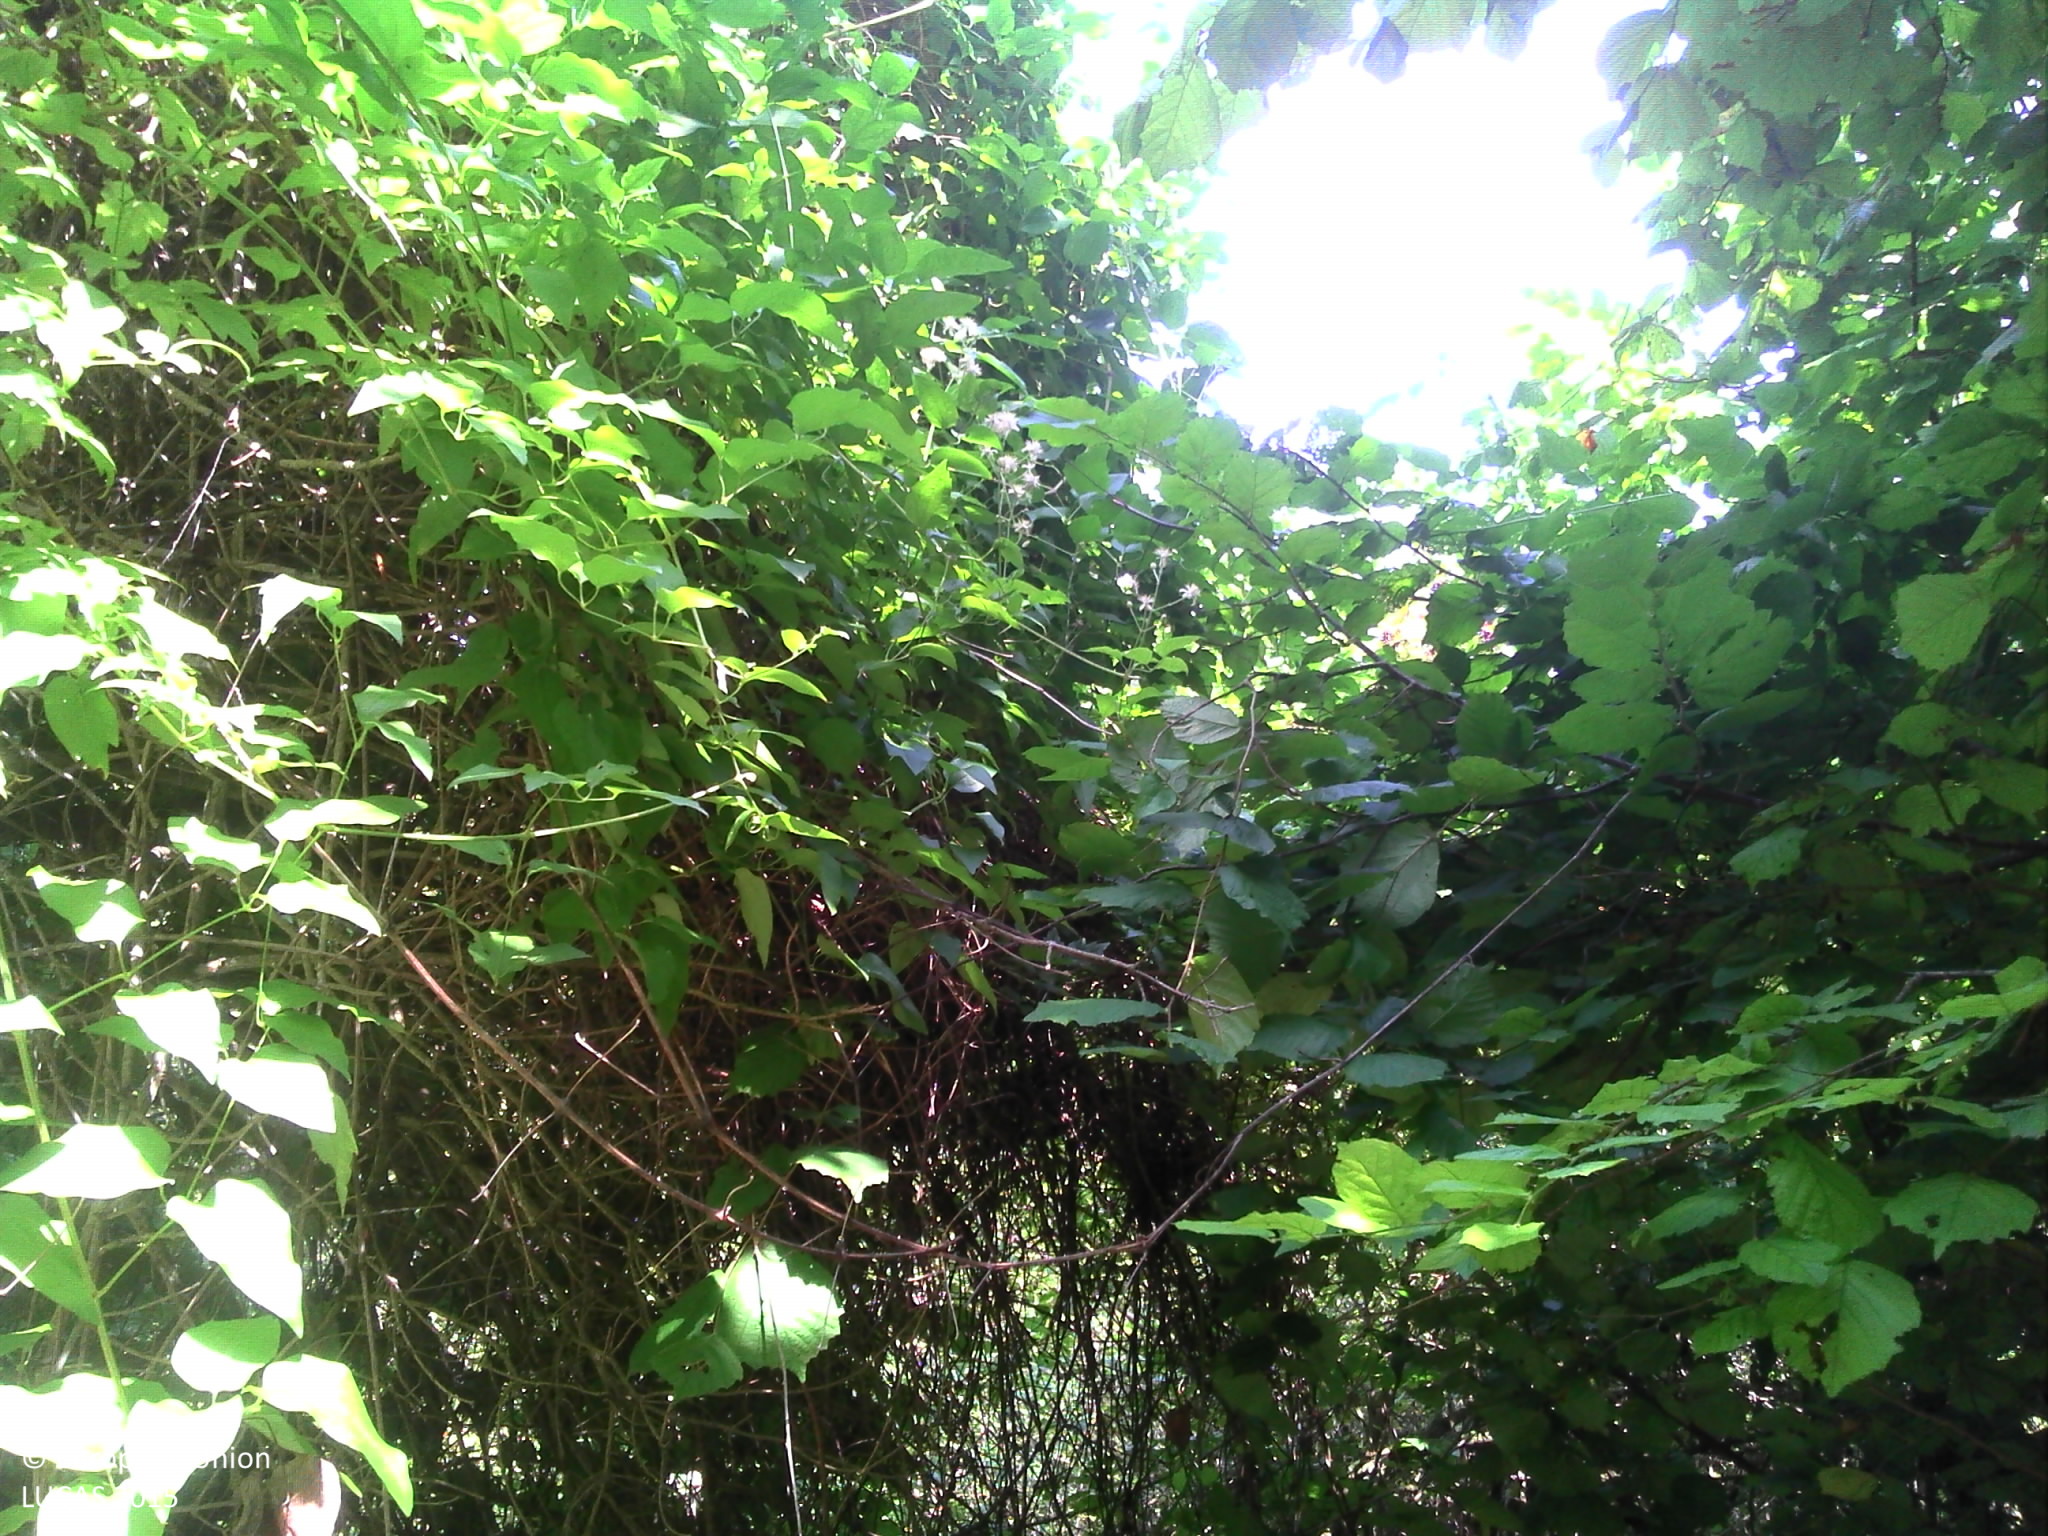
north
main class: Woodland
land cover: Broadleaved woodland
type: mesophytic deciduous forest
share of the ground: > 75 %
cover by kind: broadleaved forest trees 60 %, shrubs 25 %, herbaceous plants 10 %, lichens and mosses 5 %
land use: Forestry
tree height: > 5 m
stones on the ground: 10 - 25 %
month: August
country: FR
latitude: 47.1649
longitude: 0.1490
